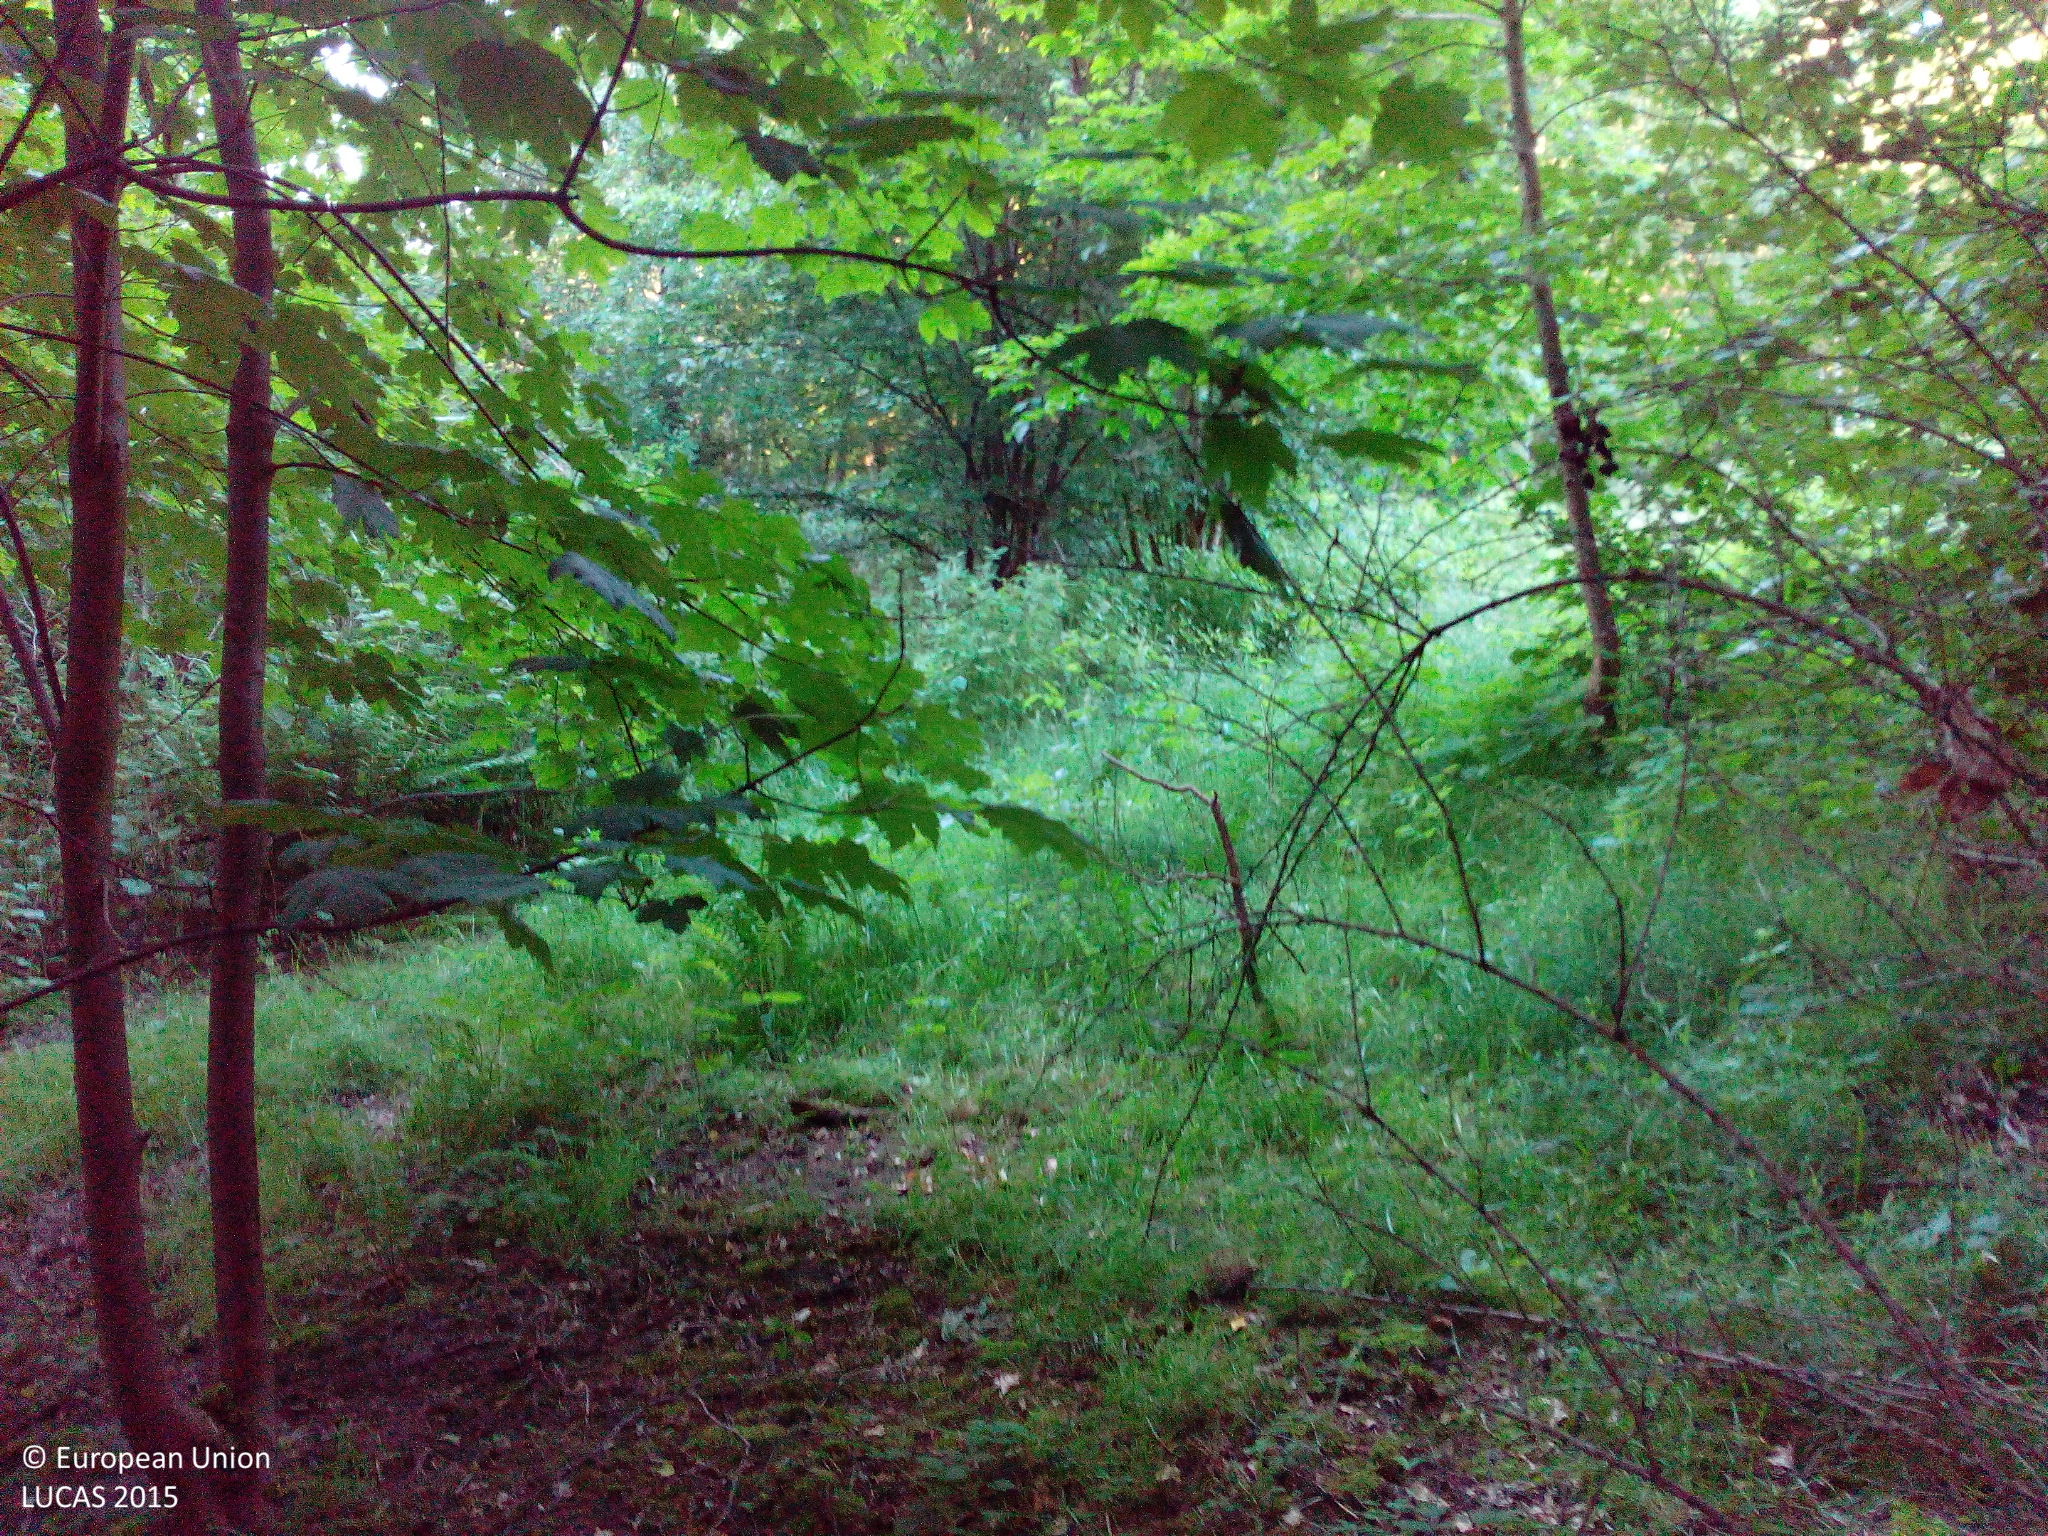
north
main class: Woodland
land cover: Broadleaved woodland
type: mesophytic deciduous forest
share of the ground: 50 - 75 %
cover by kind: broadleaved forest trees 70 %, shrubs 10 %, herbaceous plants 10 %
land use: Forestry
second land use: Amenities, museums, leisure
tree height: > 5 m
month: July
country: DK
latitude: 56.5272
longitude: 10.7306
